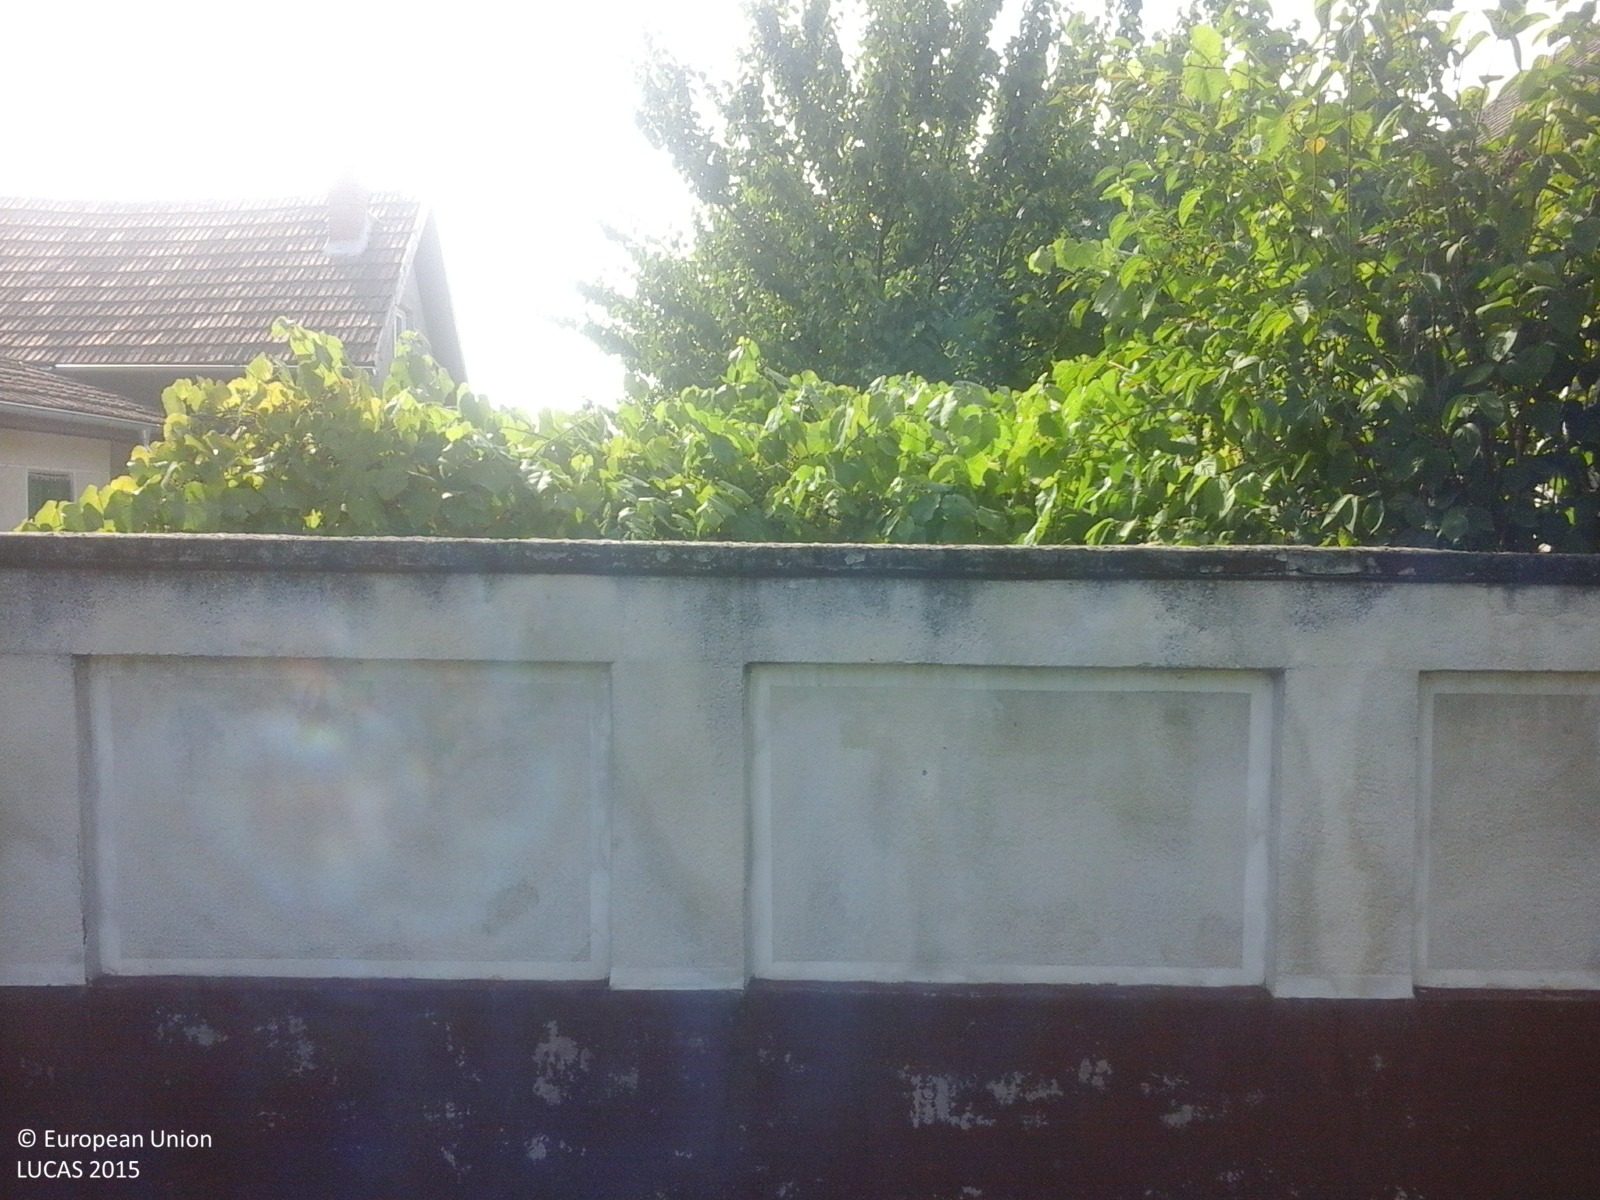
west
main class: Cropland
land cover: Vineyards
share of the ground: > 75 %
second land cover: Other bare soil
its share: > 75 %
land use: Kitchen garden
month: August
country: RO
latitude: 45.7617
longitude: 21.0213
